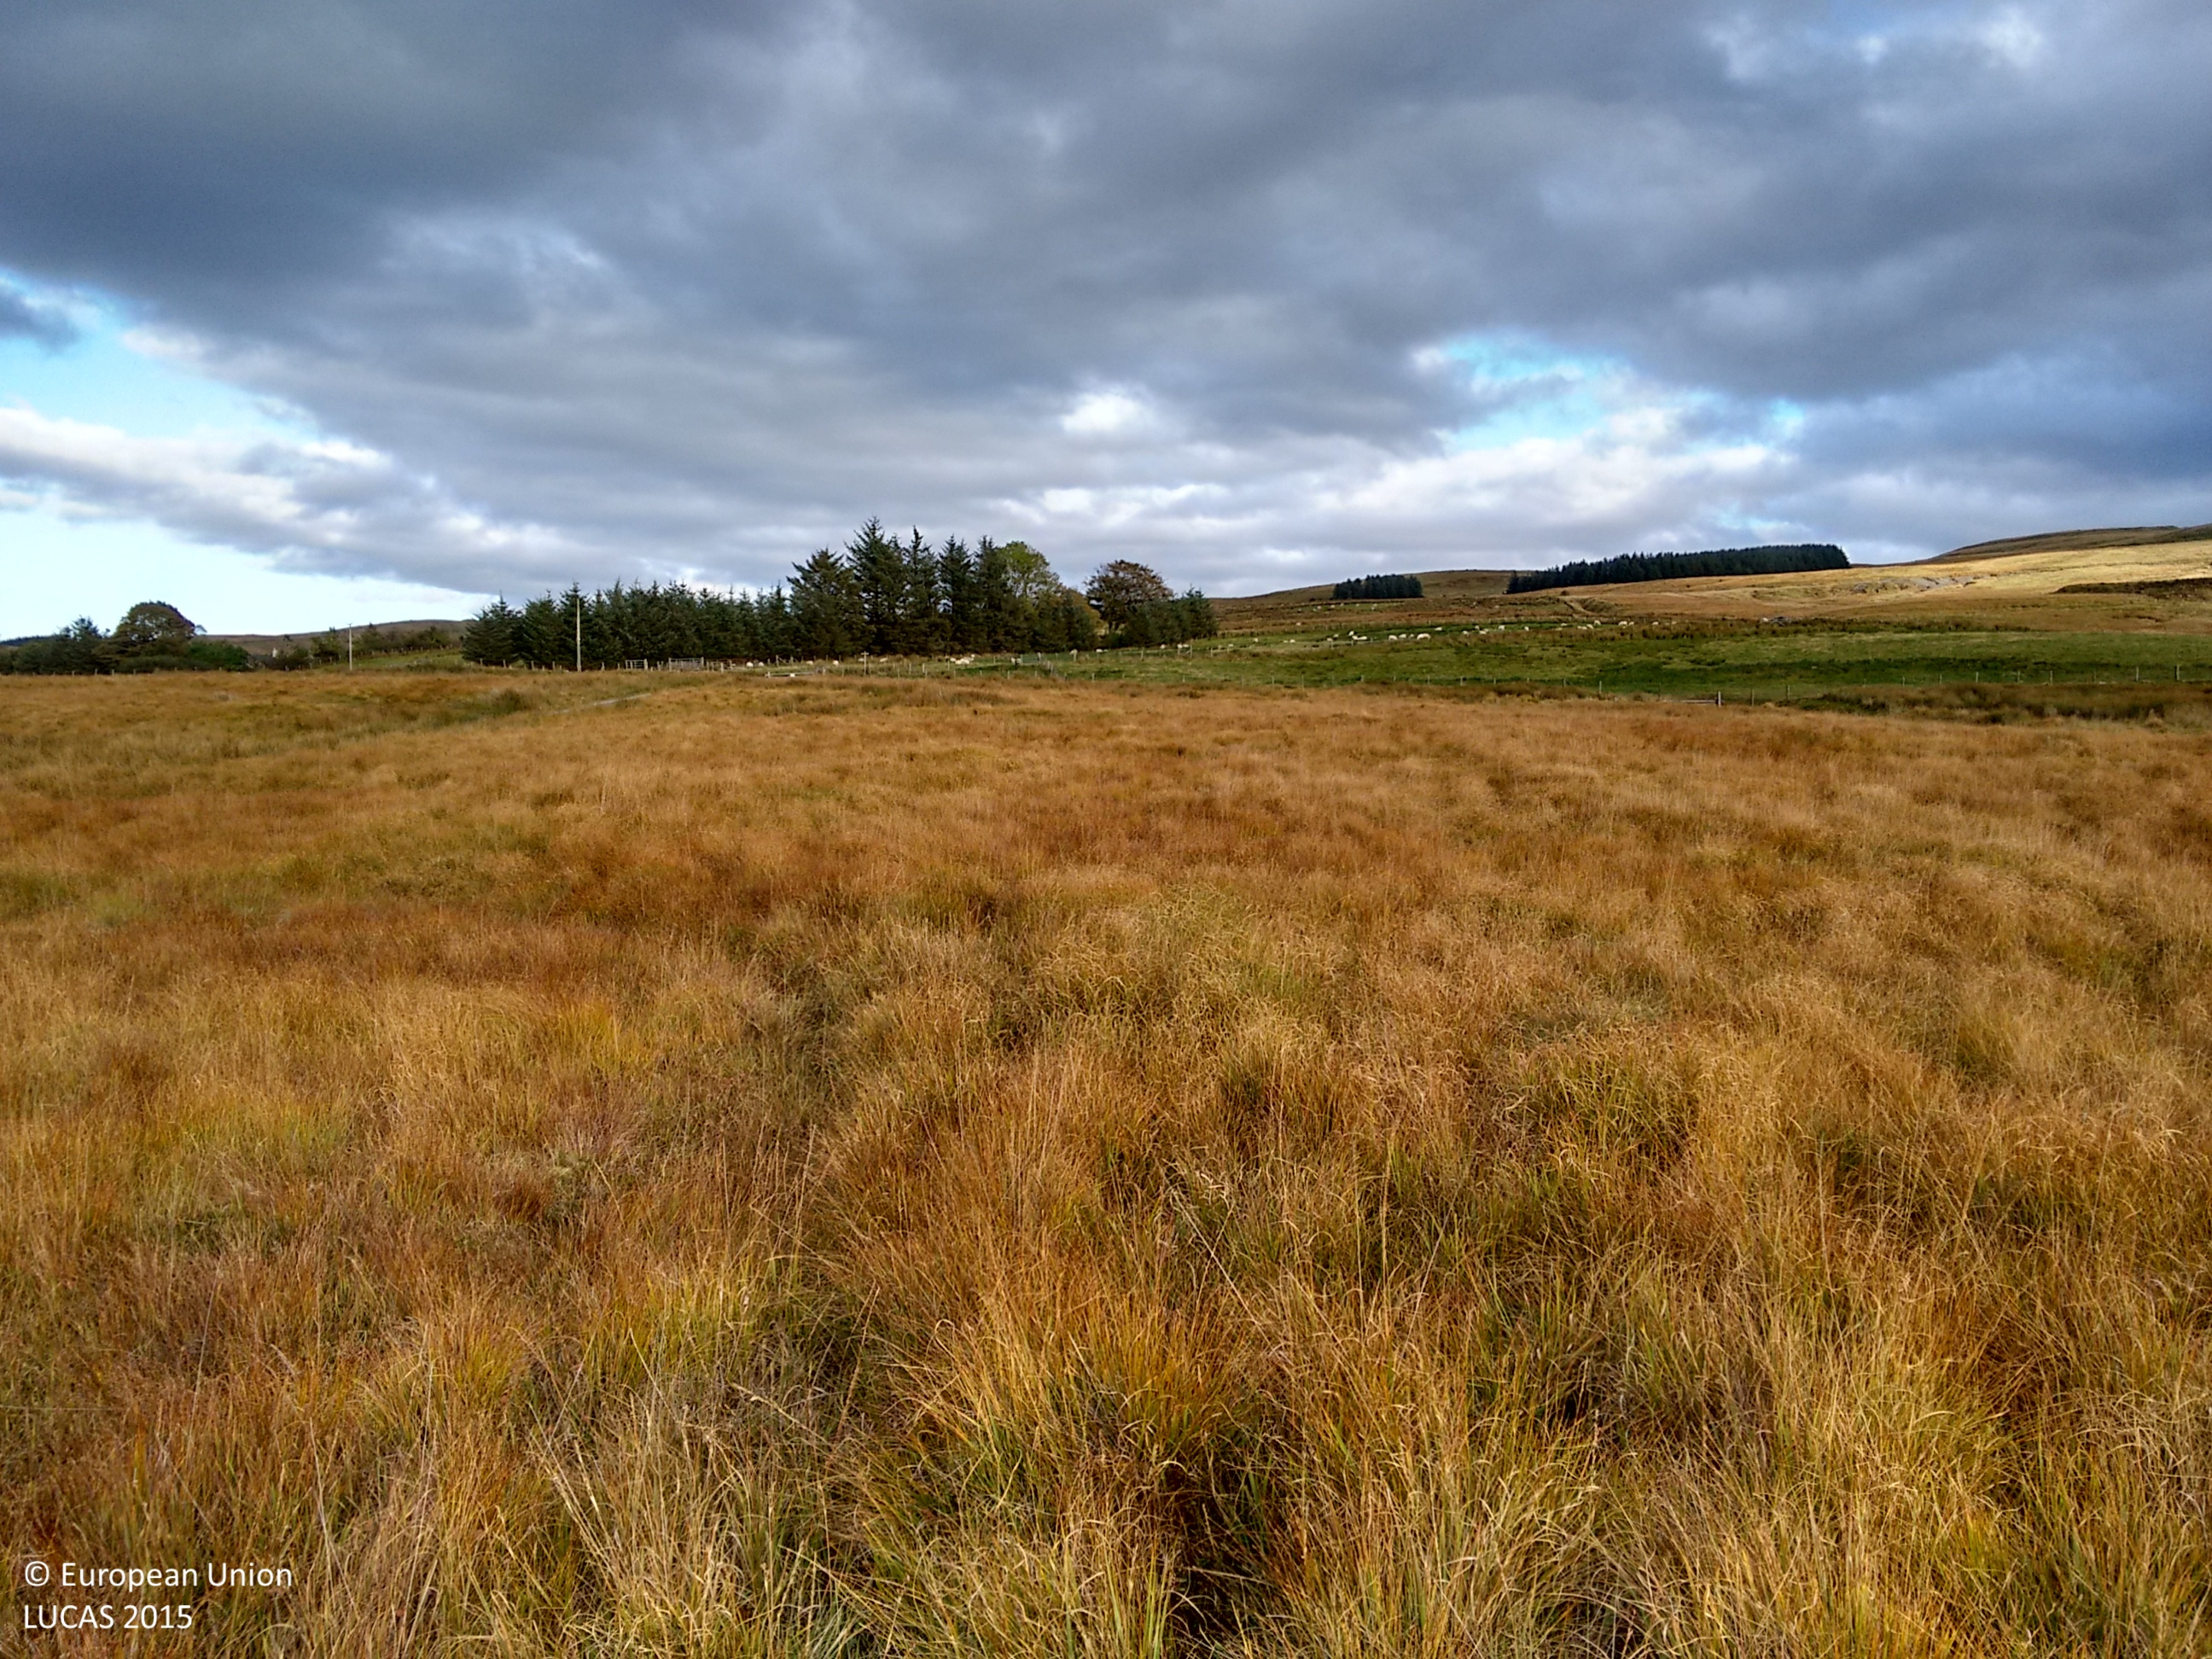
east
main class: Grassland
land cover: Grassland without tree/shrub cover
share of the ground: > 75 %
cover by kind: herbaceous plants 90 %, lichens and mosses 10 %
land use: Agriculture (excluding fallow land and kitchen gardens)
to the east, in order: Grassland without tree/shrub cover; Fences; Ditches and canals; Grassland without tree/shrub cover; Paved roads, cycling and walking lanes; Fences; Grassland without tree/shrub cover; Fences; Lines of trees; Grassland without tree/shrub cover; Artificial constructions in urban areas
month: October
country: GB
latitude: 52.3105
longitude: -3.8348
